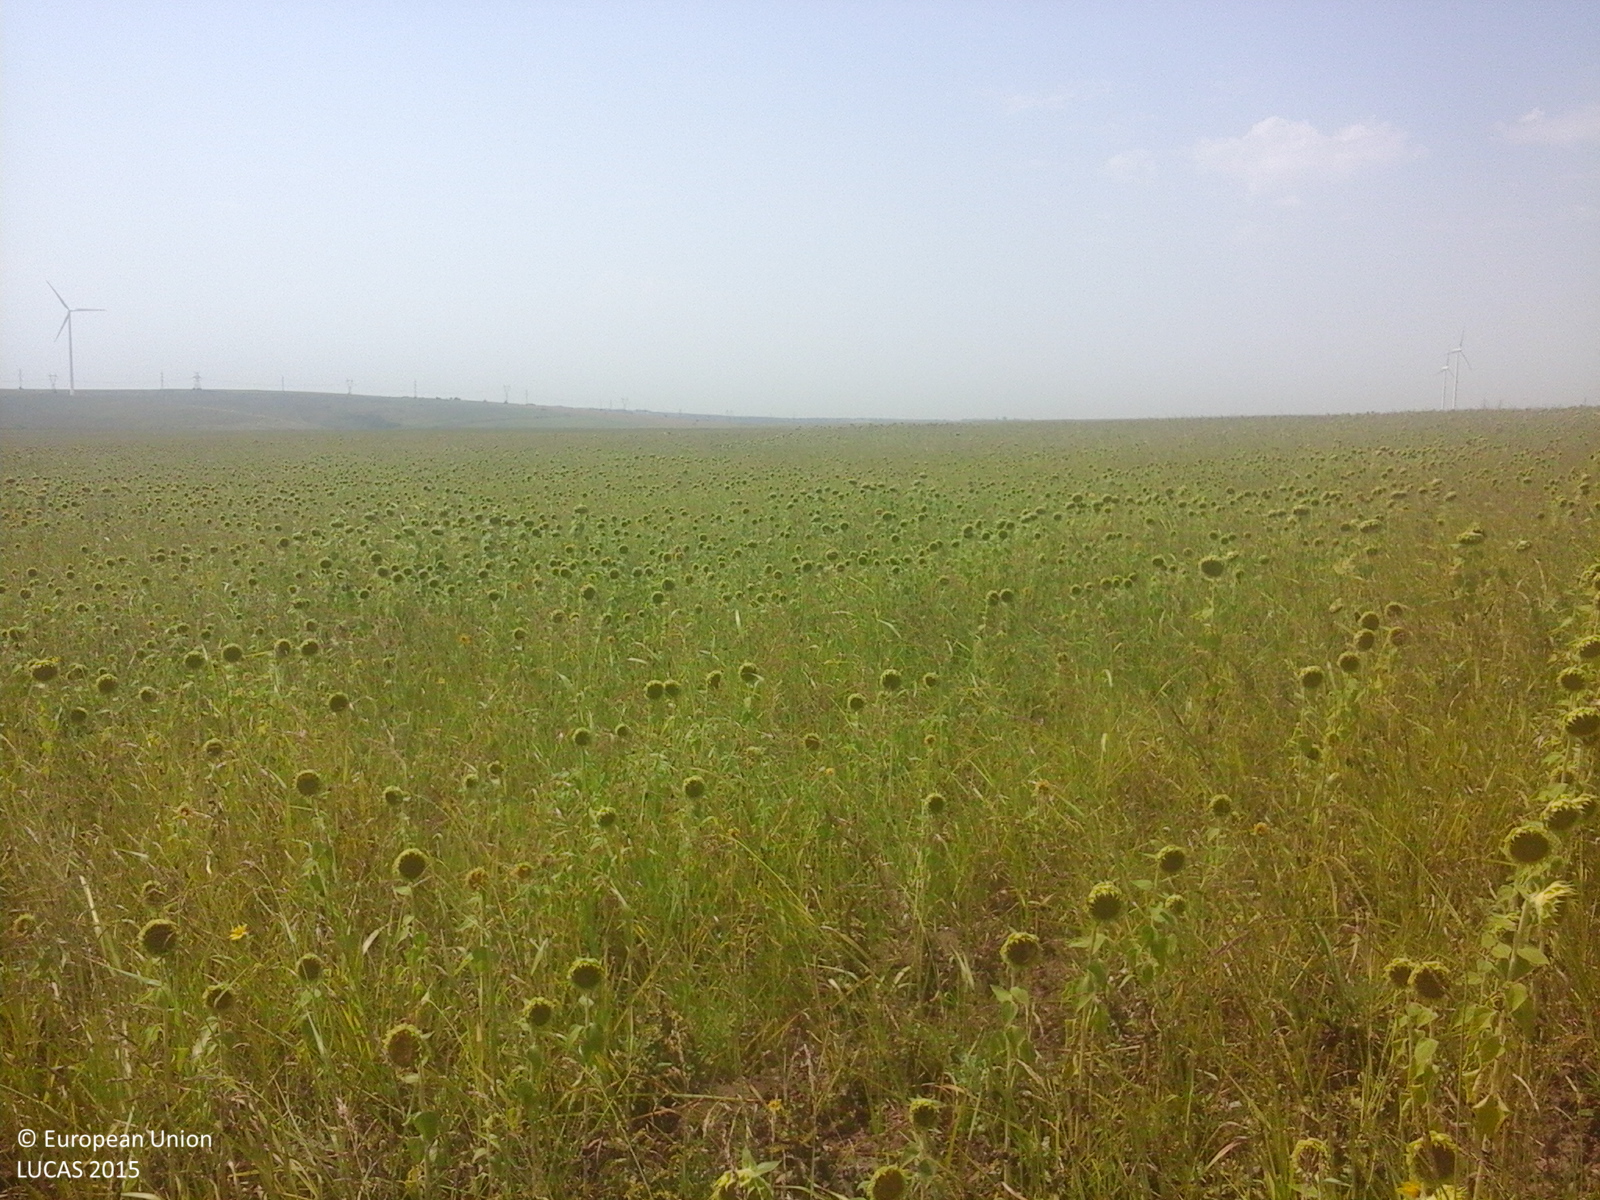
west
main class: Cropland
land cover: Sunflower
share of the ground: > 75 %
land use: Agriculture (excluding fallow land and kitchen gardens)
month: August
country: RO
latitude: 44.3066
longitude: 28.1229
